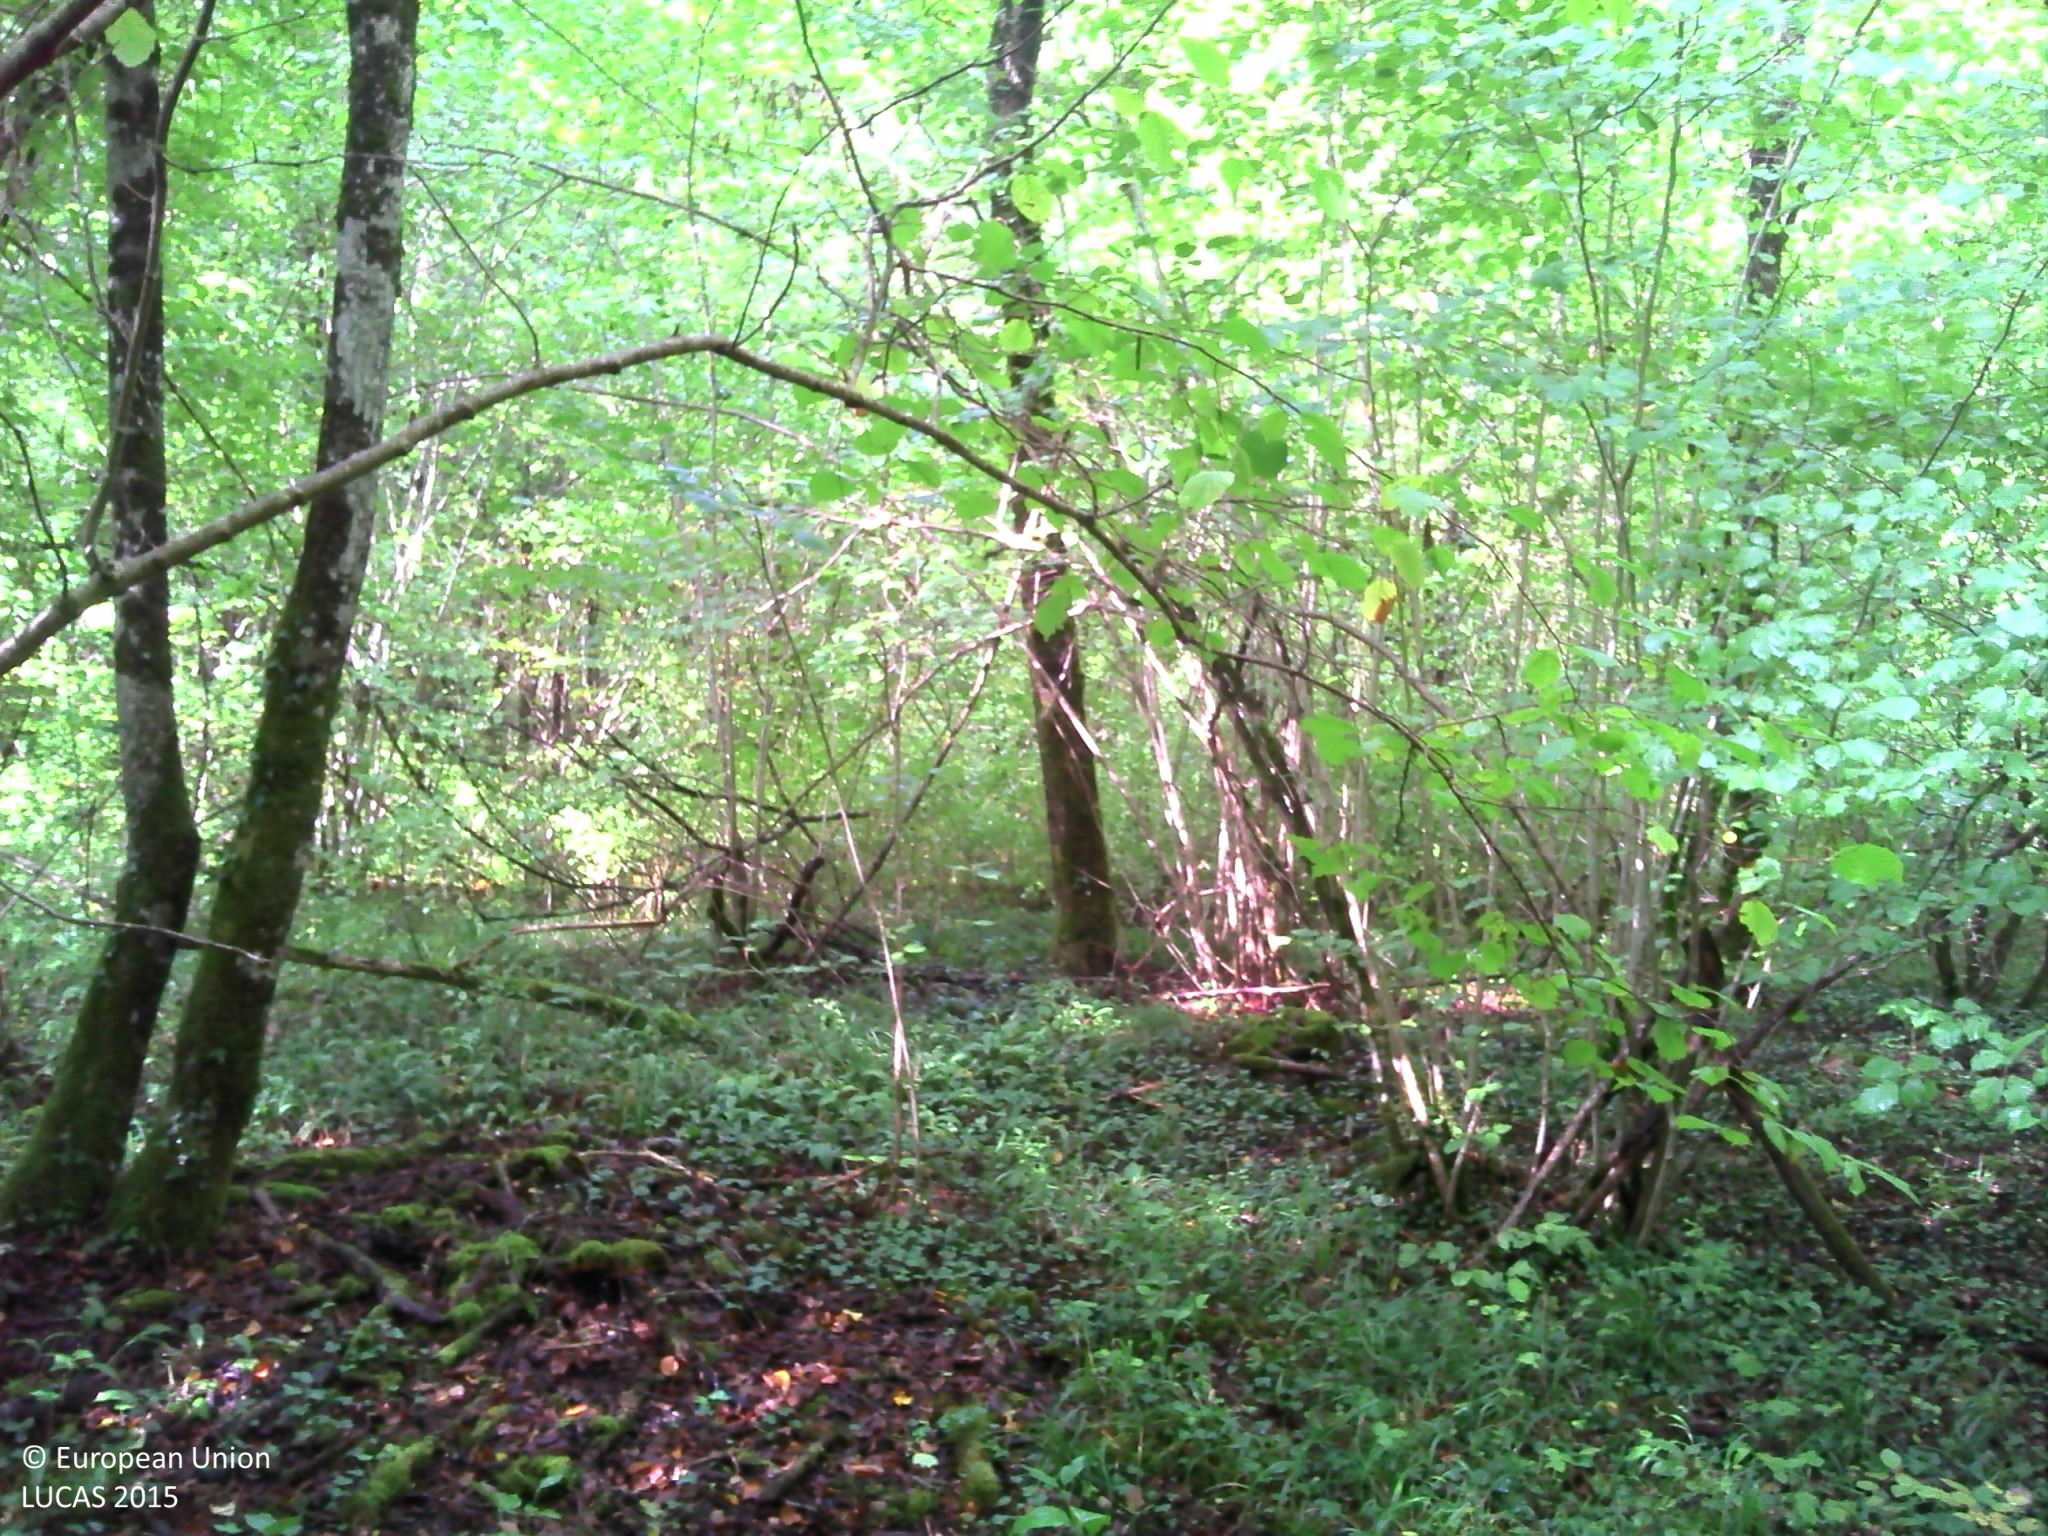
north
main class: Woodland
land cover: Broadleaved woodland
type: mesophytic deciduous forest
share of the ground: > 75 %
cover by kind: broadleaved forest trees 90 %, herbaceous plants 5 %, lichens and mosses 5 %
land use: Forestry
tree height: > 5 m
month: September
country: FR
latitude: 47.6784
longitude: 4.2838
